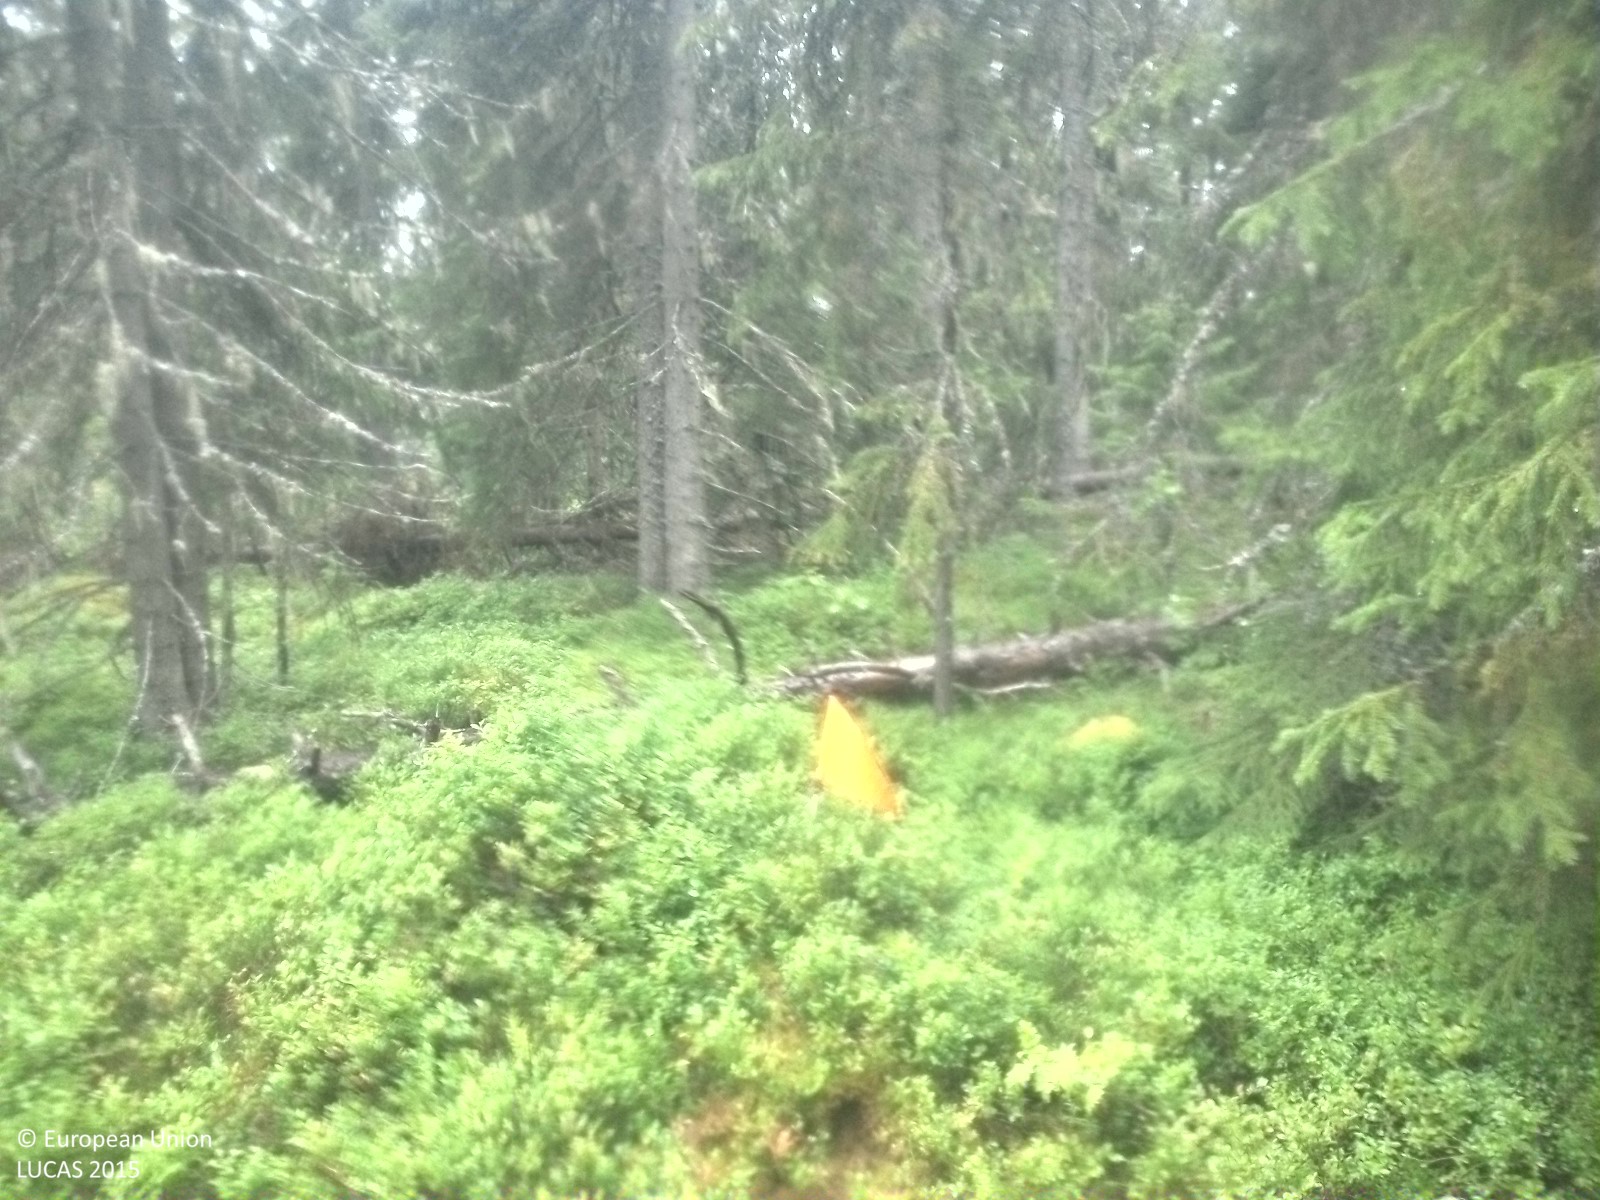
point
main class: Woodland
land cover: Spruce dominated coniferous woodland
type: boreal forest
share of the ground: 50 - 75 %
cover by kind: coniferous forest trees 55 %, shrubs 40 %, broadleaved forest trees 5 %
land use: Forestry
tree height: > 5 m
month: August
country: SE
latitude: 62.2643
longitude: 16.2786
